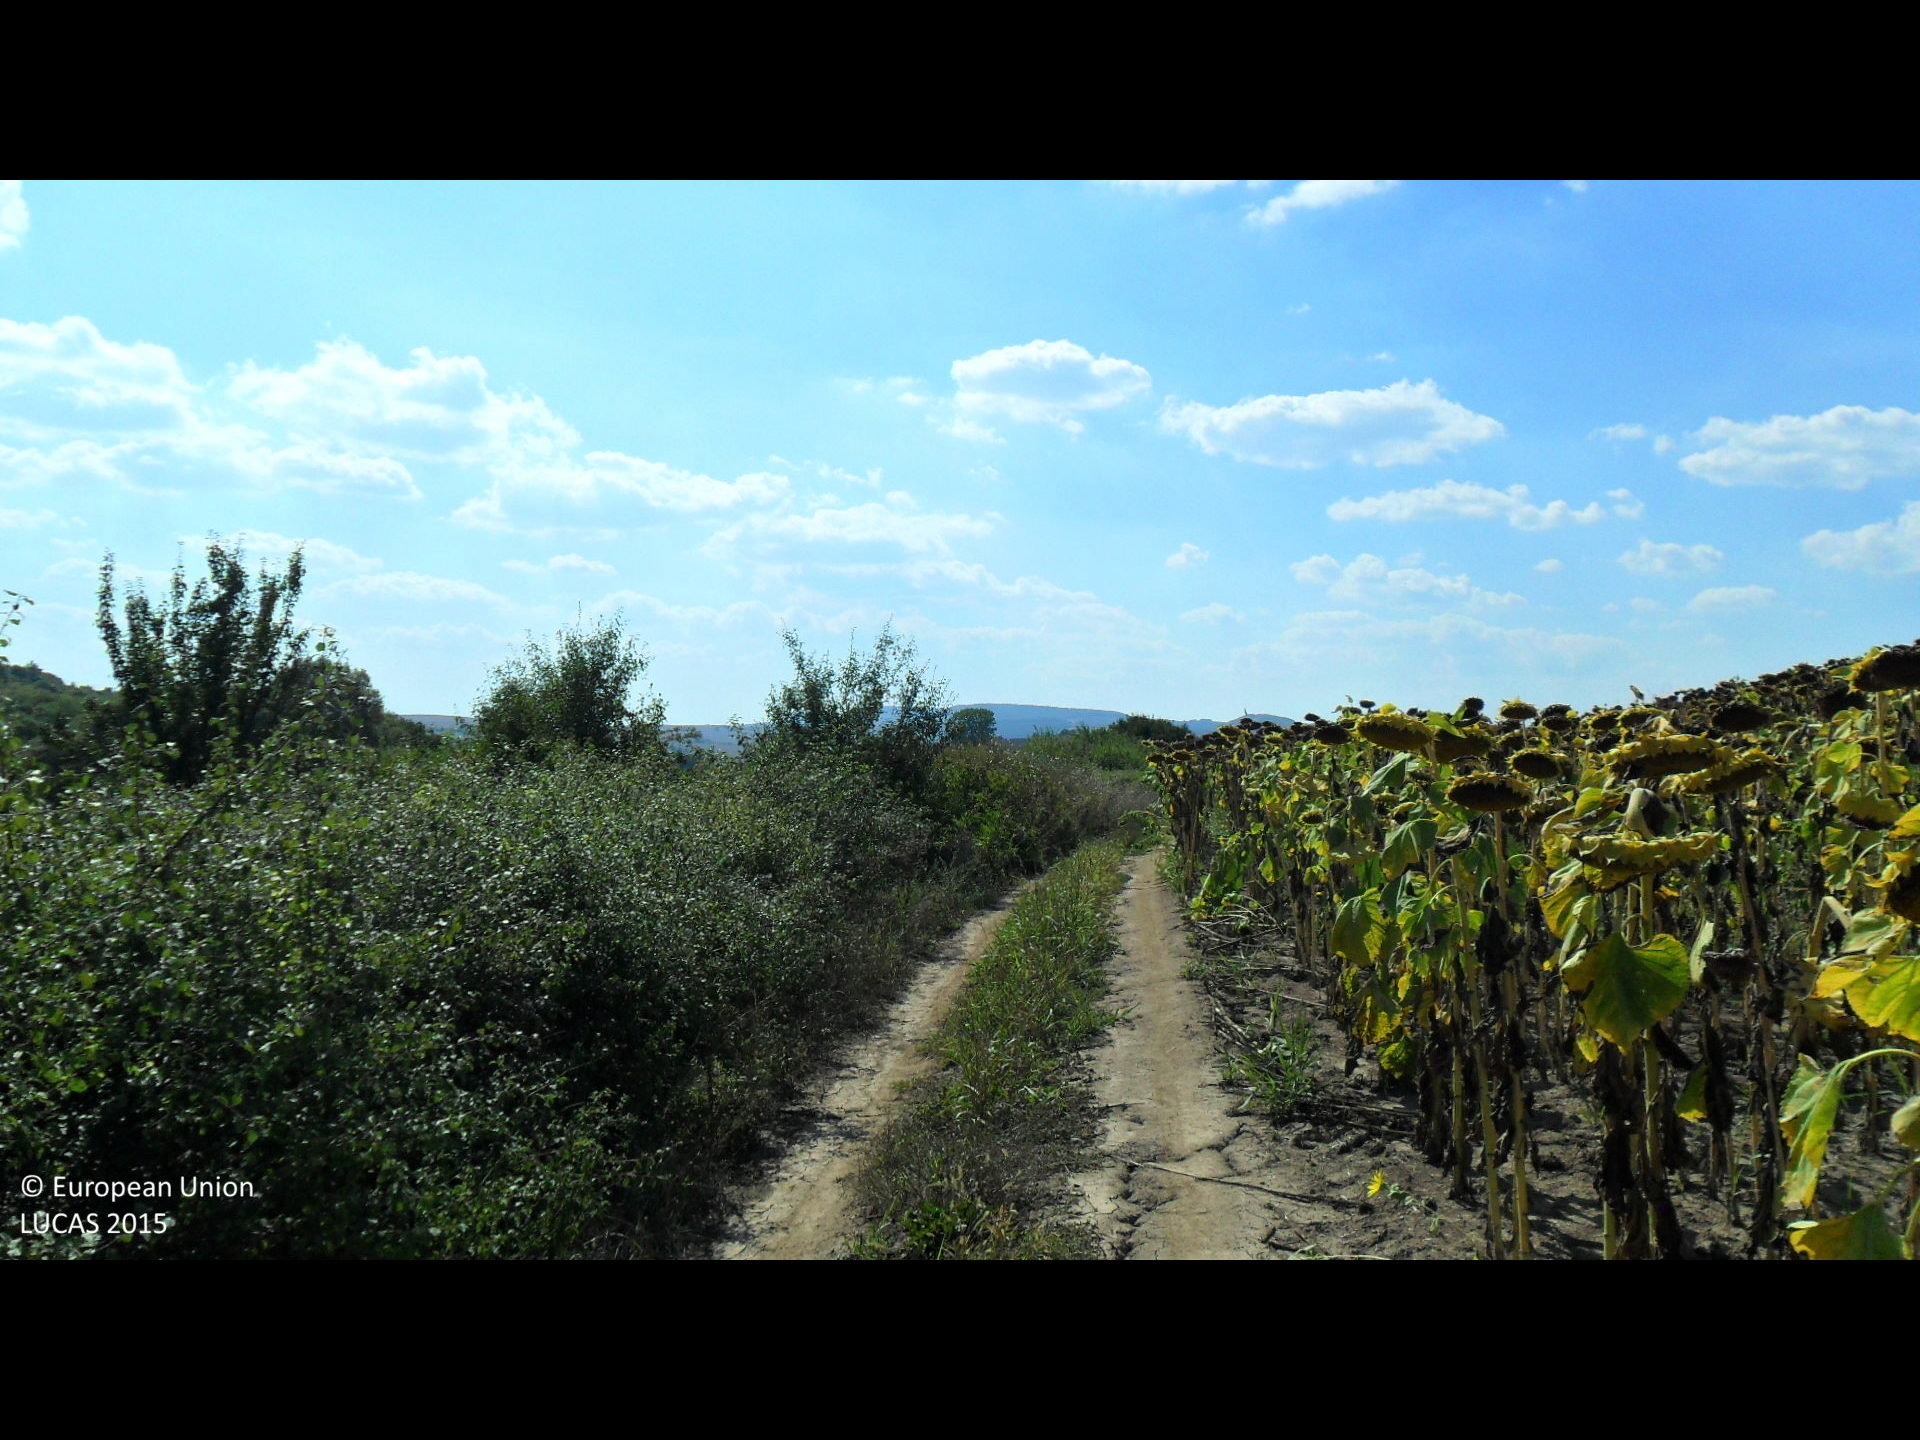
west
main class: Cropland
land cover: Sunflower
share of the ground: > 75 %
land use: Agriculture (excluding fallow land and kitchen gardens)
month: August
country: BG
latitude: 43.4650
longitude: 26.3545
